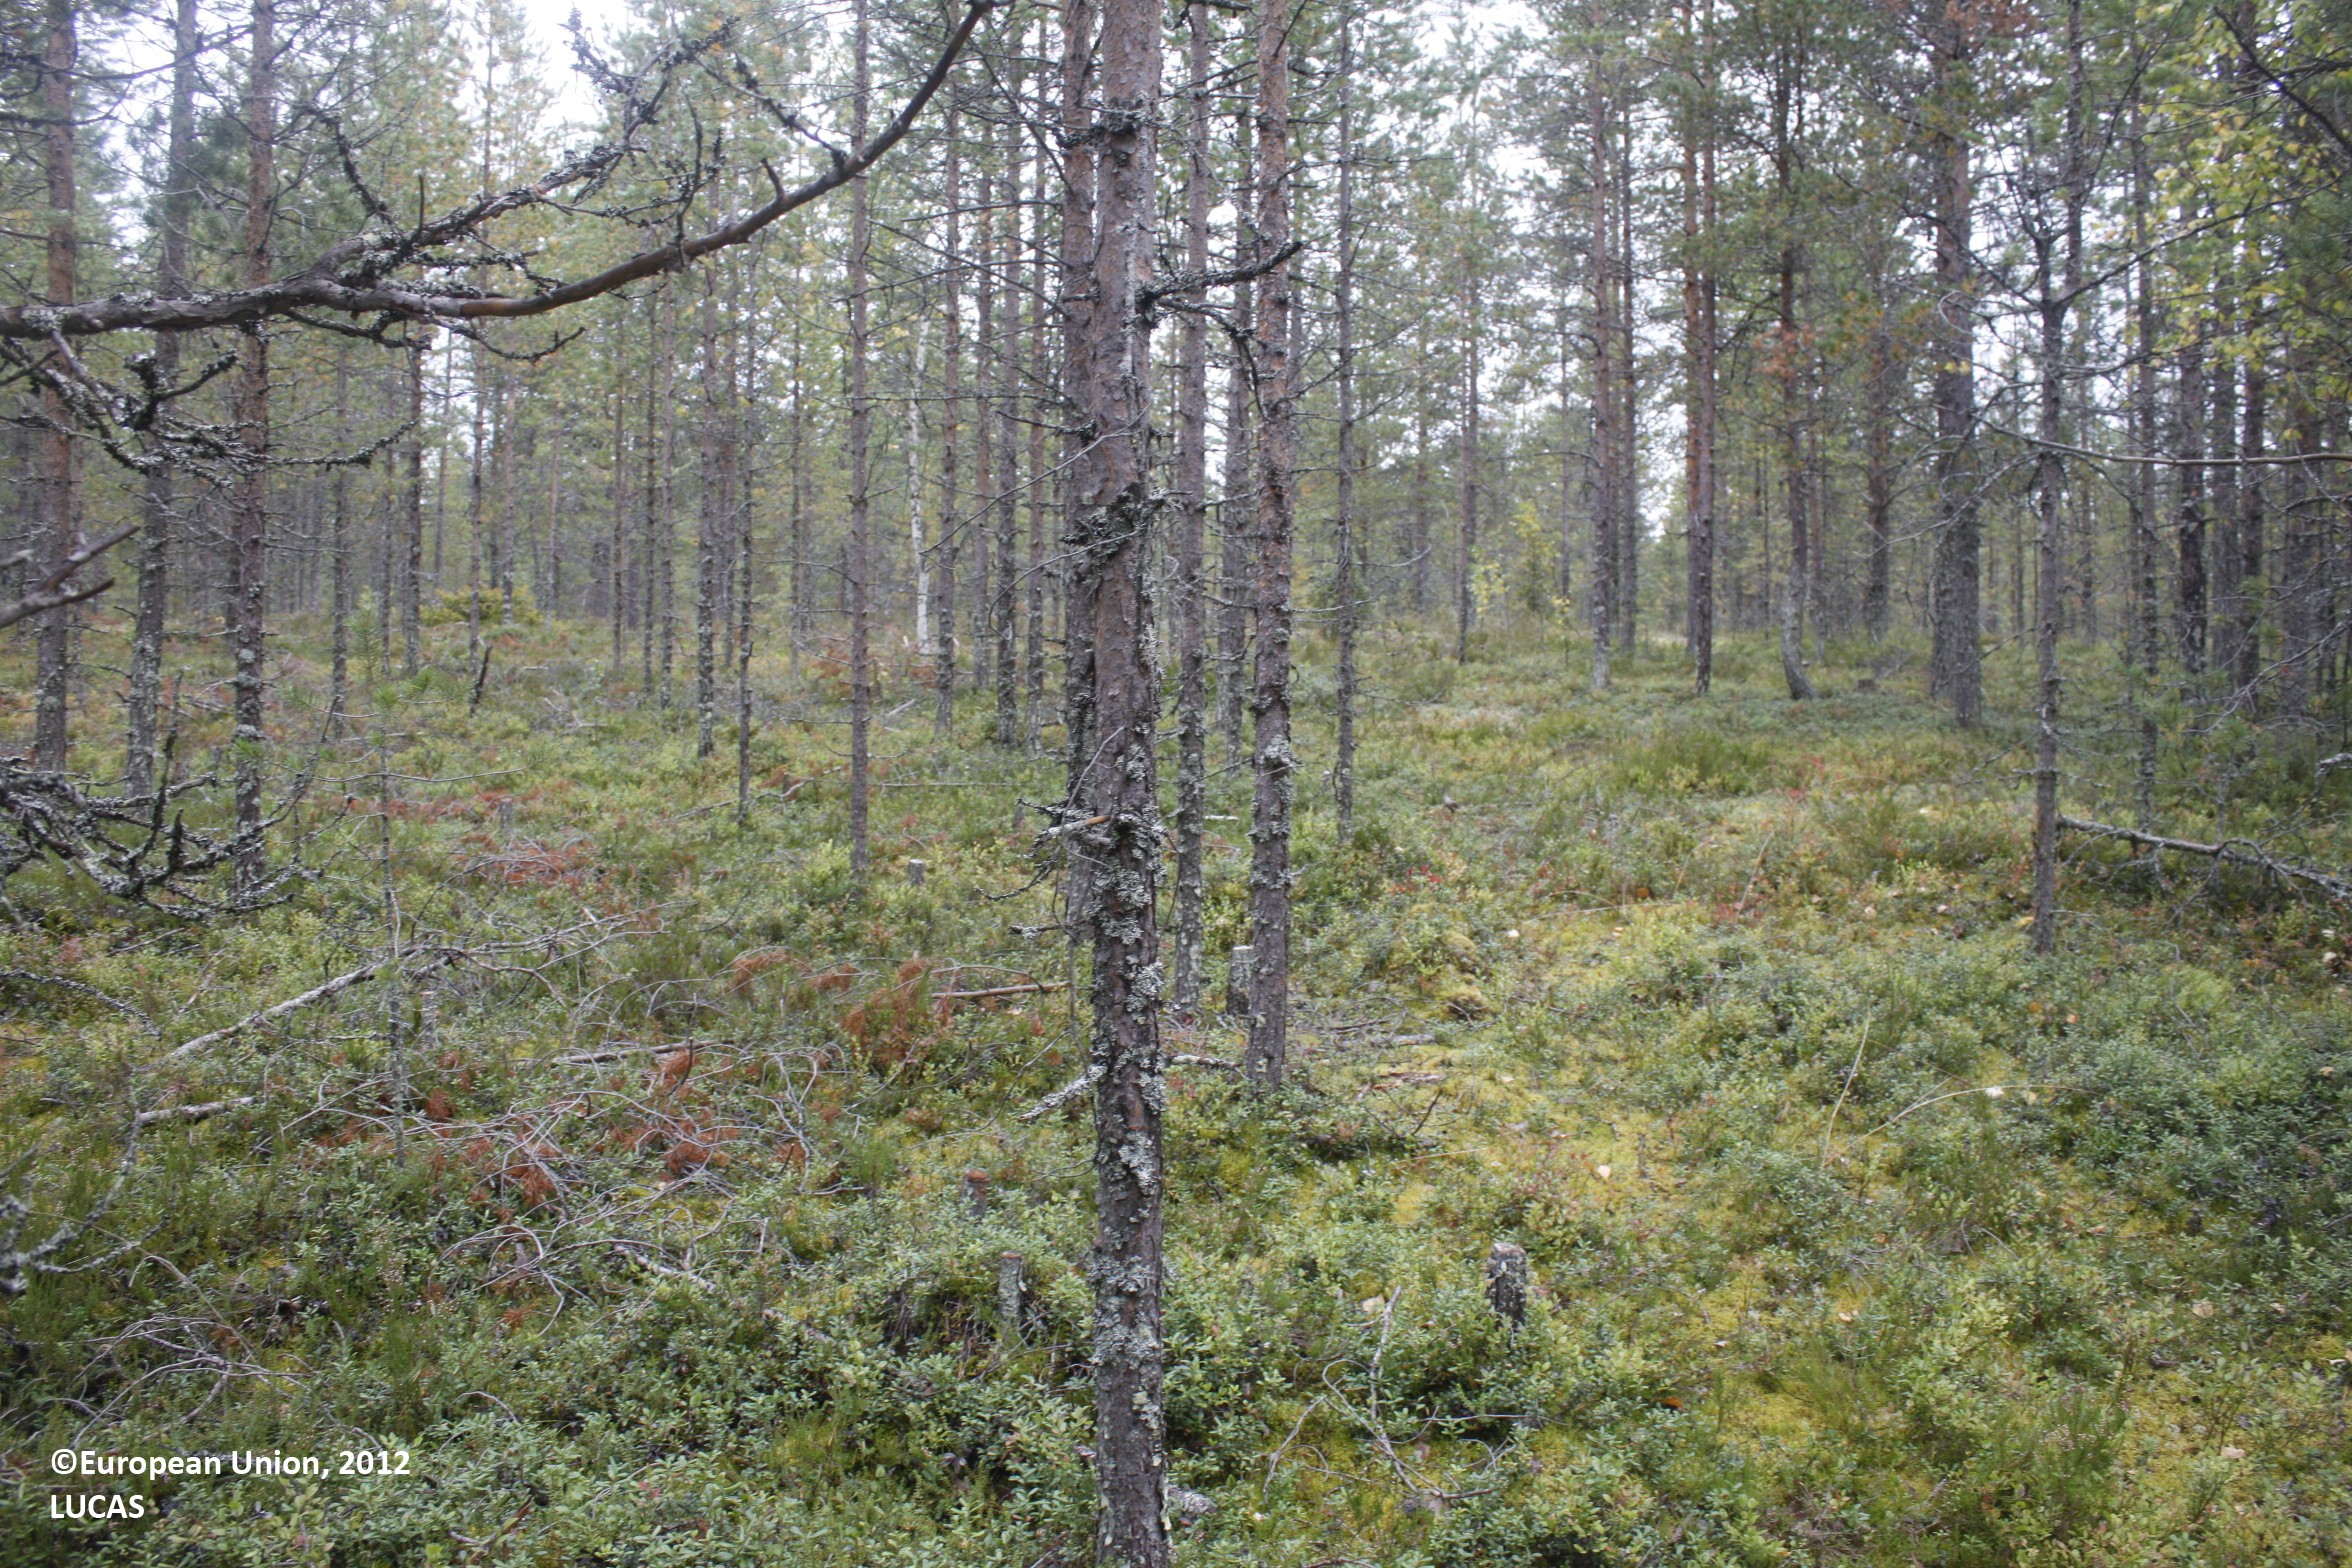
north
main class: Woodland
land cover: Pine dominated coniferous woodland
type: boreal forest
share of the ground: 50 - 75 %
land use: Forestry
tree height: > 5 m
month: September
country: FI
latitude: 65.1181
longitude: 26.7052
